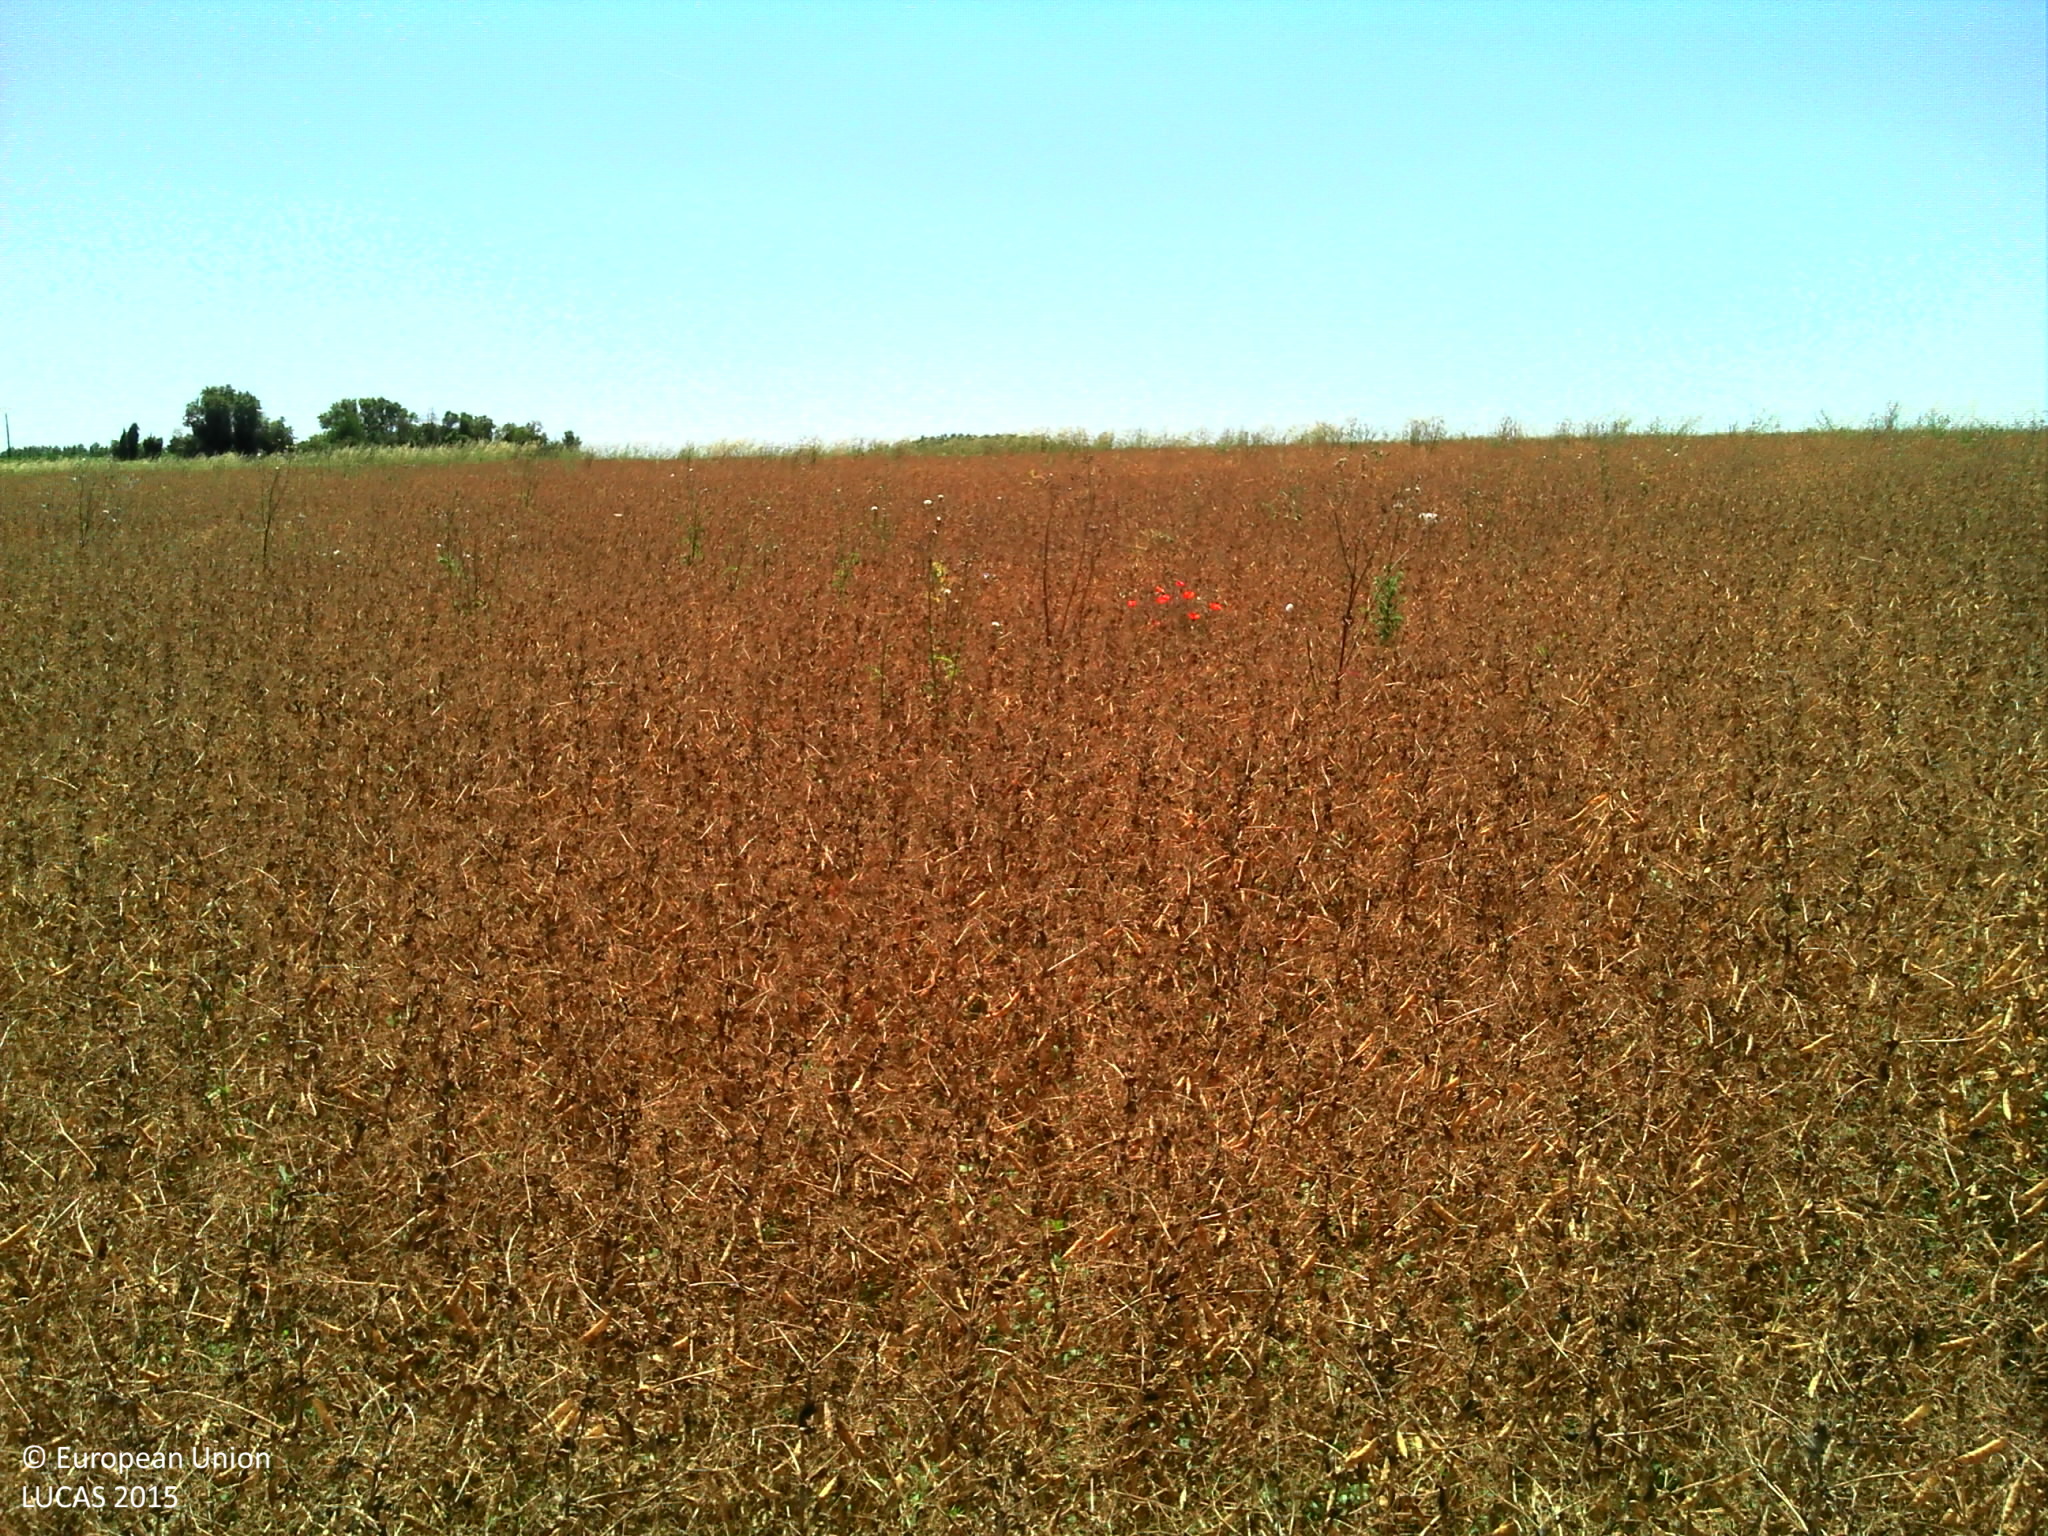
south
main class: Cropland
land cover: Dry pulses
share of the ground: > 75 %
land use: Agriculture (excluding fallow land and kitchen gardens)
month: June
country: FR
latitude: 45.8517
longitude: -0.6753
